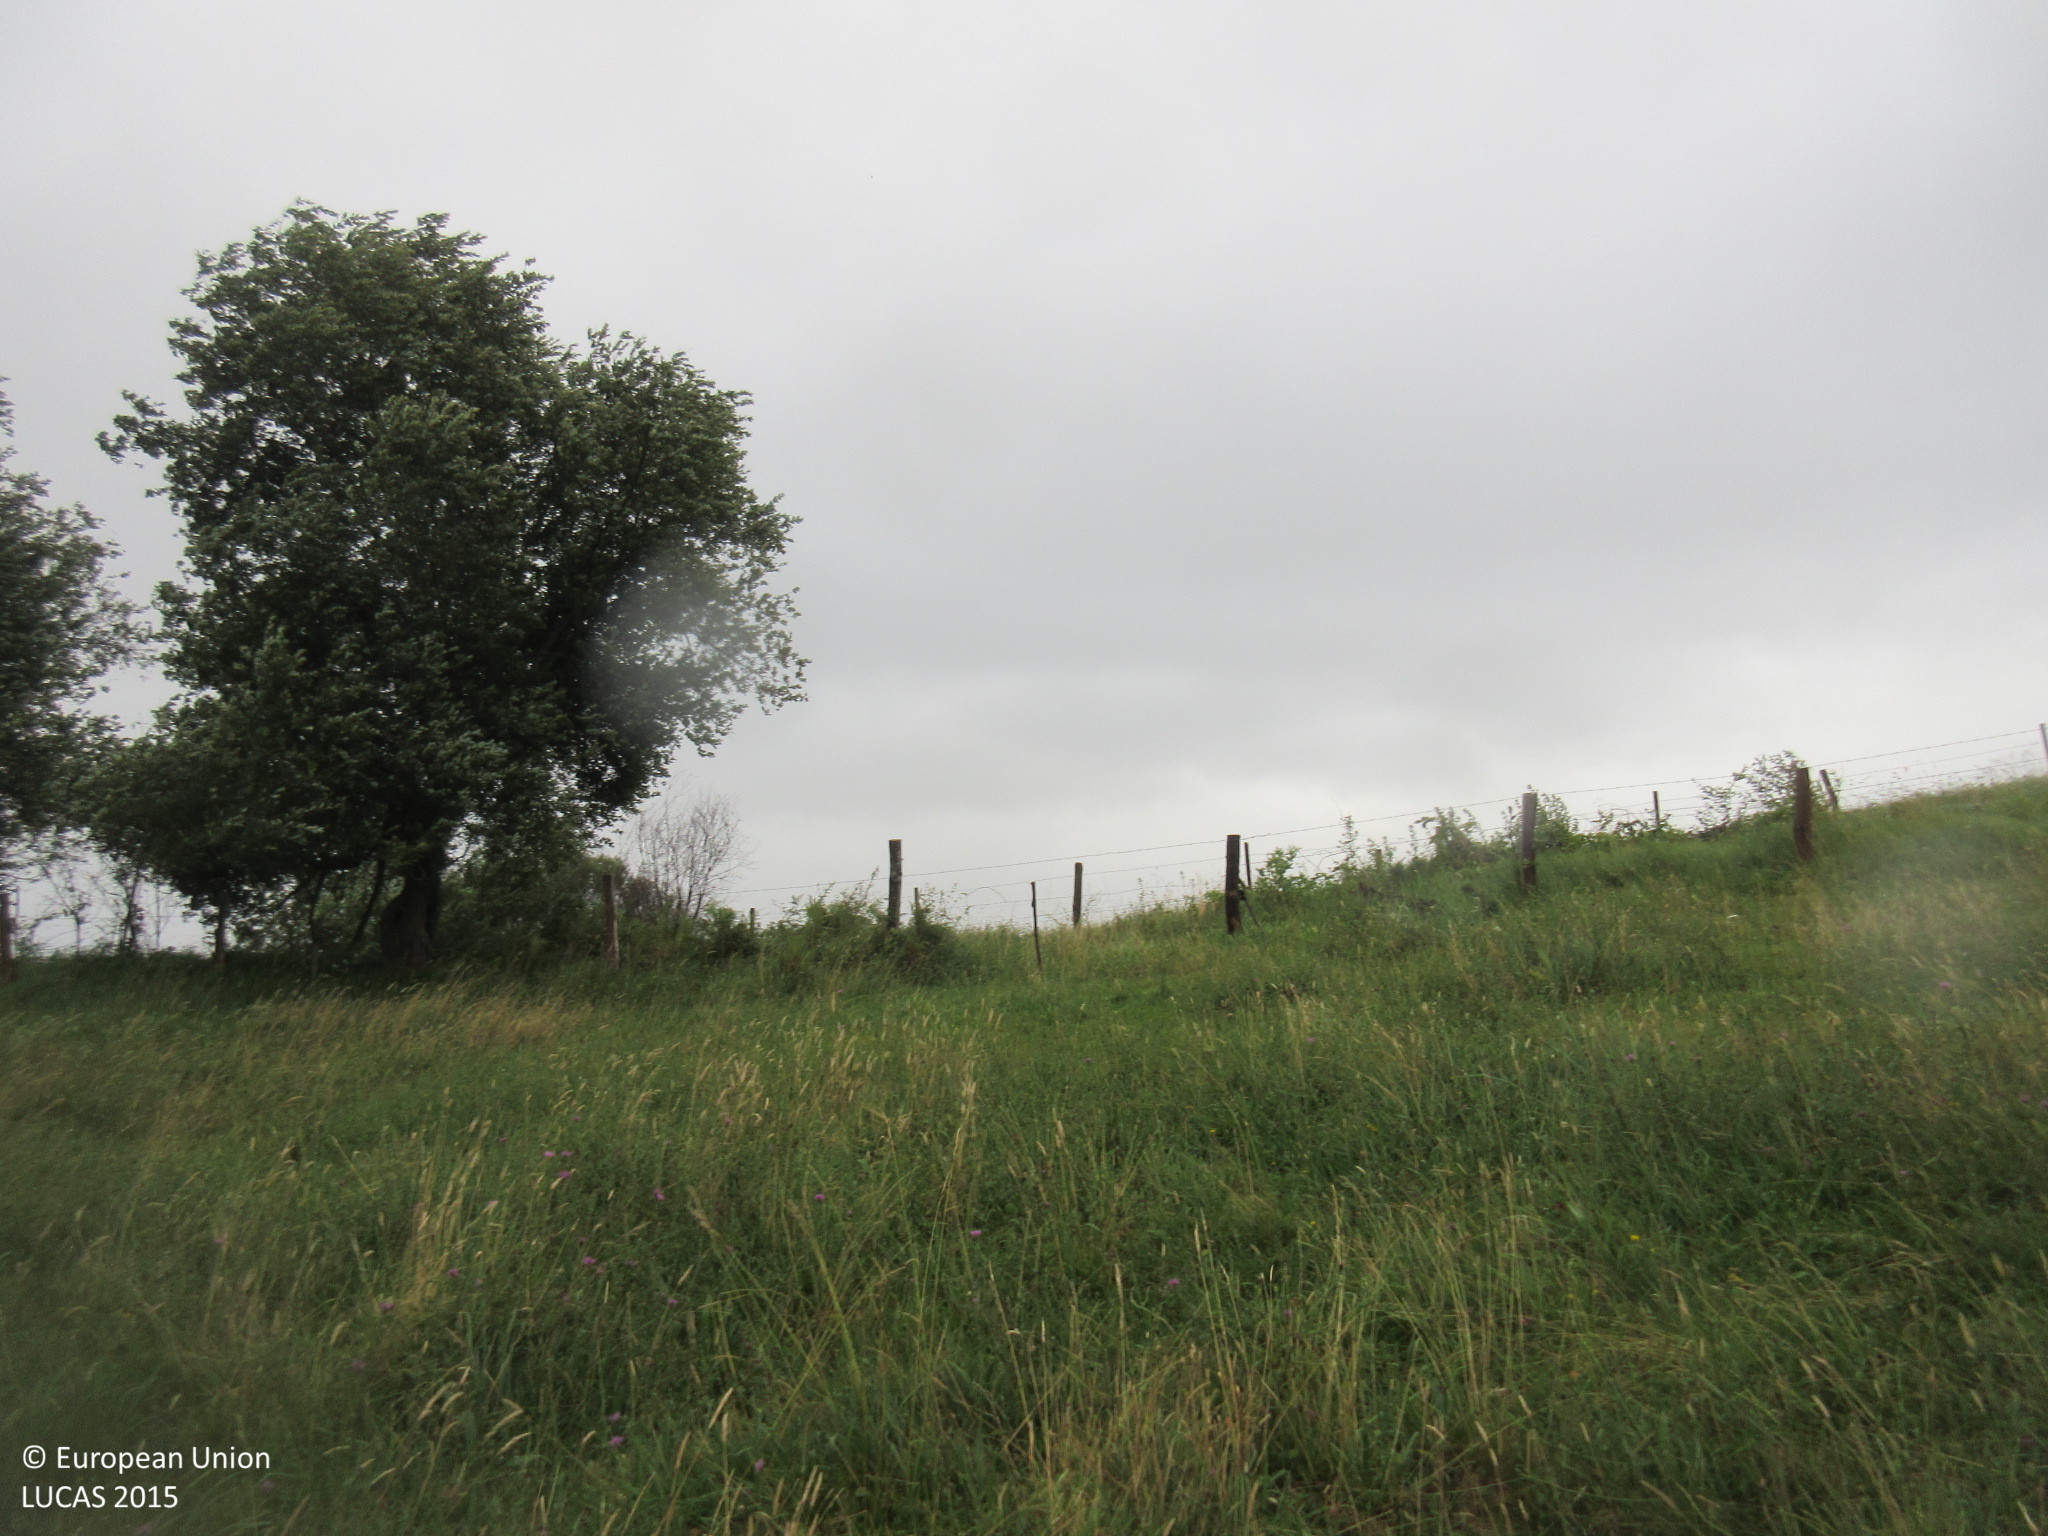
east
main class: Grassland
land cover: Grassland without tree/shrub cover
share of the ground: > 75 %
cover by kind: herbaceous plants 100 %
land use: Agriculture (excluding fallow land and kitchen gardens)
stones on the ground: < 10 %
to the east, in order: Grassland without tree/shrub cover; Fences; Shruby margins; Tracks; Grass margins; Fences; Shrubland with sparse tree cover; Grassland without tree/shrub cover; Abandoned hedges; Grassland without tree/shrub cover; Single bushes/trees; Grassland without tree/shrub cover
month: July
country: ES
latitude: 43.3540
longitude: -4.5581
